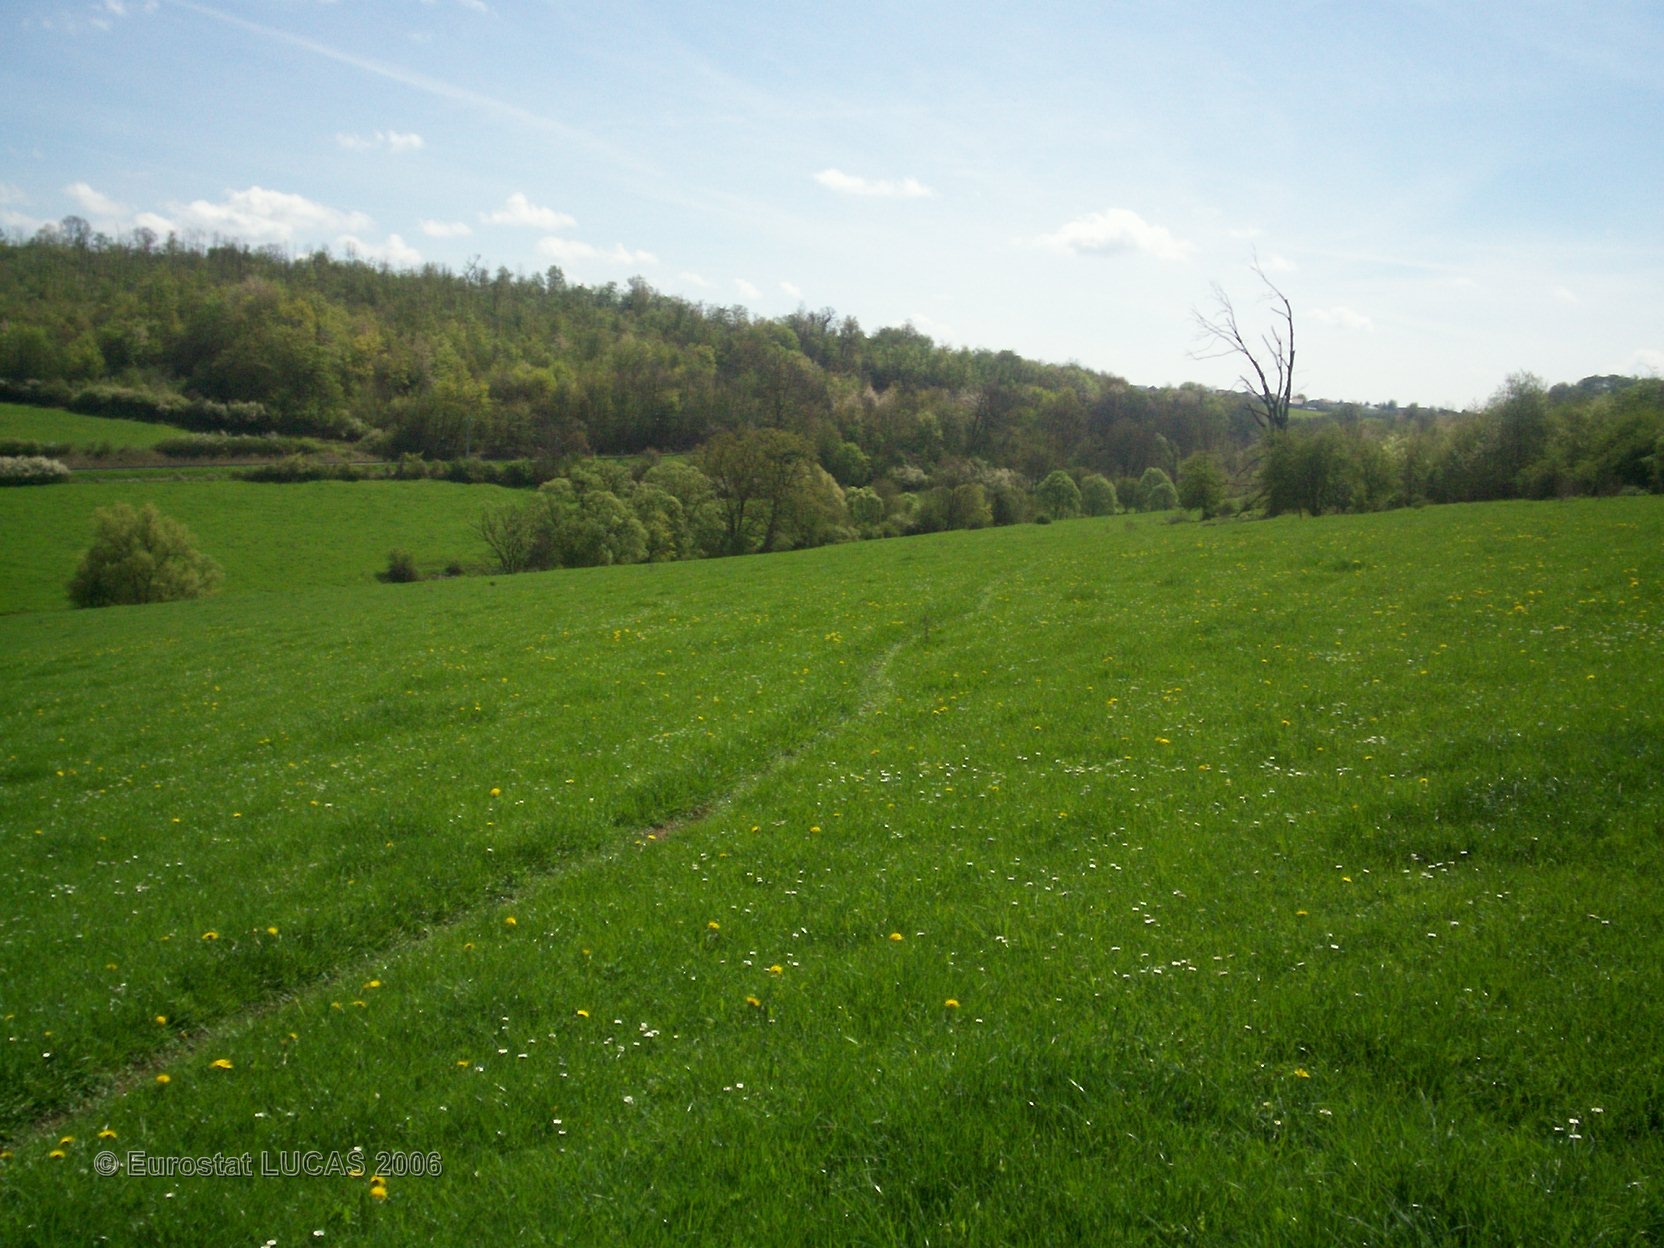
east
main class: Grassland
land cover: Grassland without tree/shrub cover
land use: Agriculture (excluding fallow land and kitchen gardens)
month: May
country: FR
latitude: 49.1129
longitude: 6.7808
